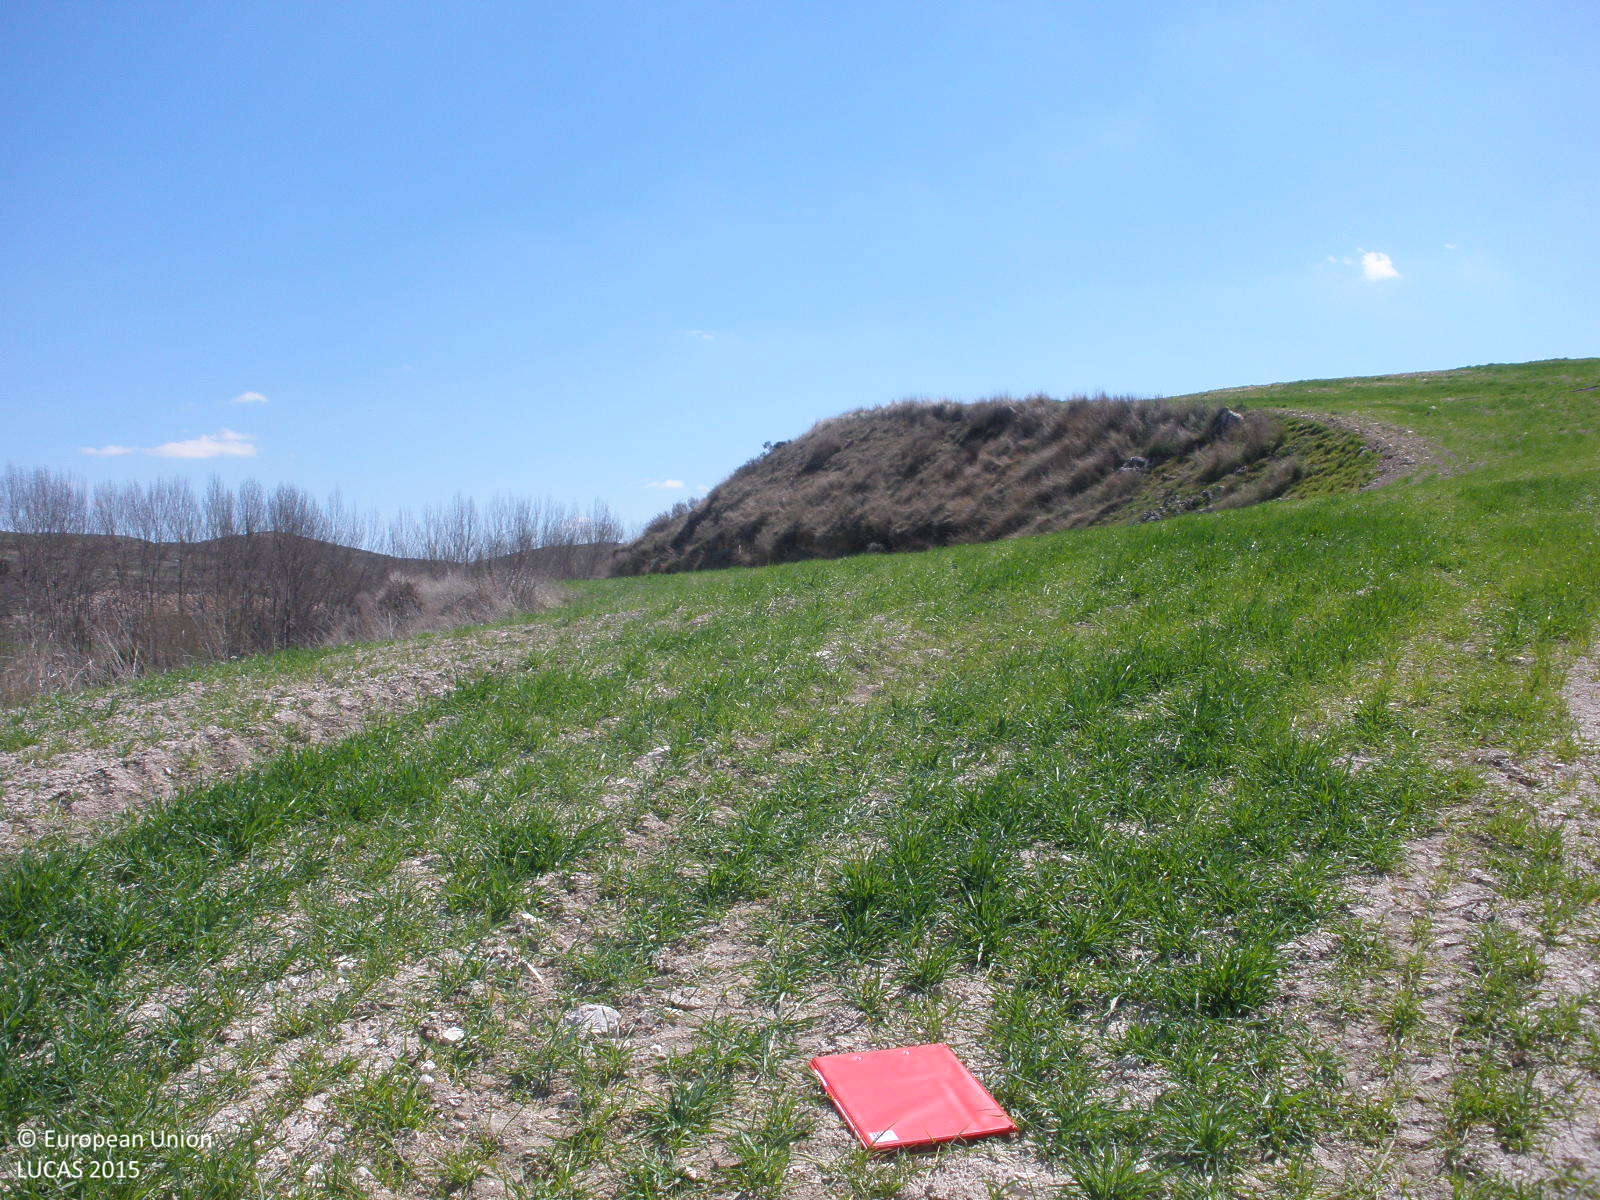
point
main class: Cropland
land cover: Barley
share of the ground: 50 - 75 %
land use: Agriculture (excluding fallow land and kitchen gardens)
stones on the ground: 10 - 25 %
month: April
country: ES
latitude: 40.8898
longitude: -1.1374
